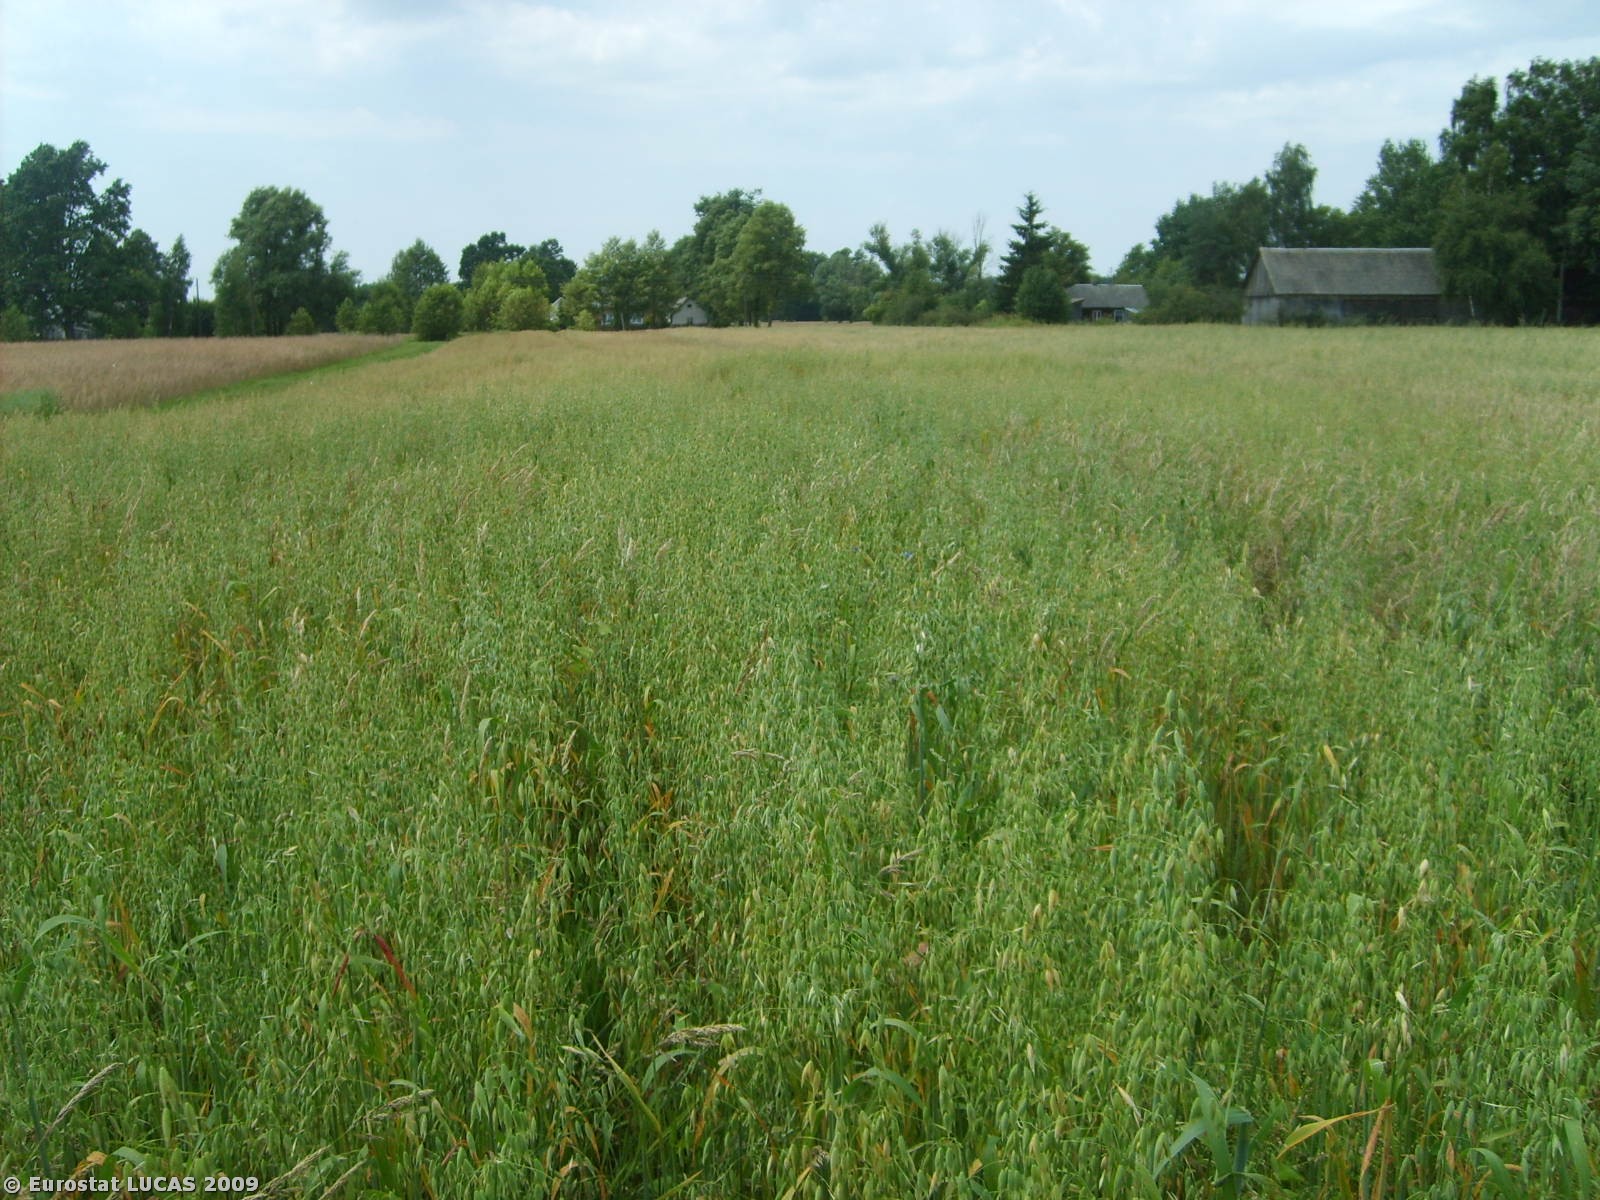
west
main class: Cropland
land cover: Oats
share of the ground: > 75 %
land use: Agriculture (excluding fallow land and kitchen gardens)
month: July
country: PL
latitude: 52.4544
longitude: 21.6638
